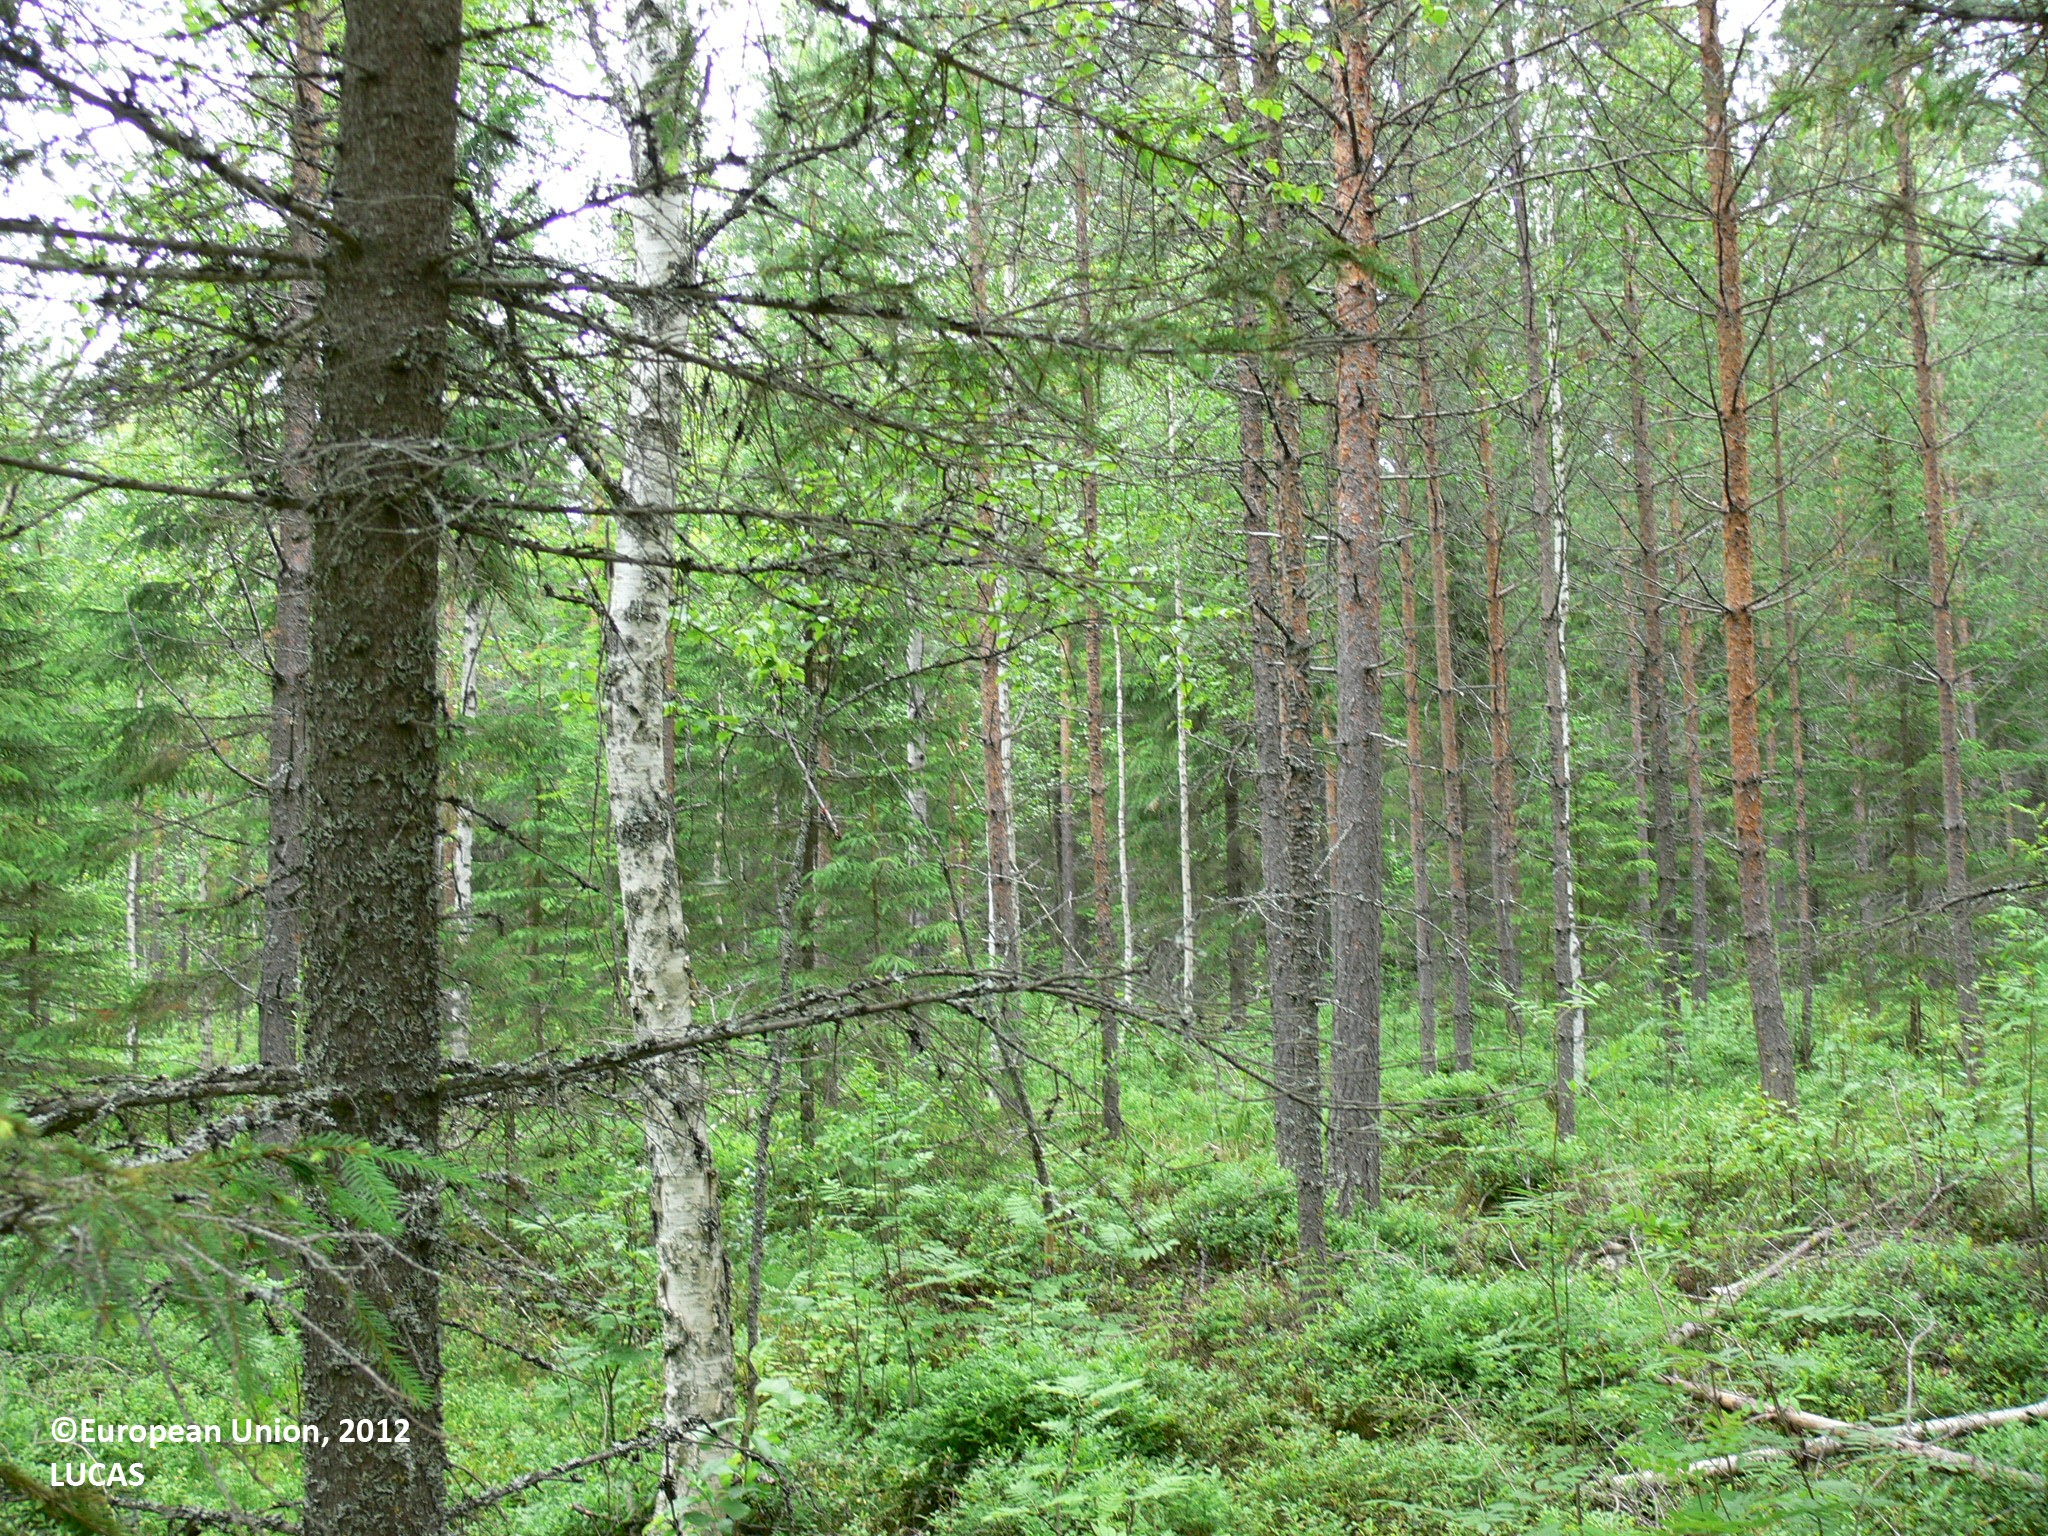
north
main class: Woodland
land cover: Other mixed woodland
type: boreal forest
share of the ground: > 75 %
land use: Forestry
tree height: > 5 m
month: June
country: FI
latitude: 62.8462
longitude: 29.3800
